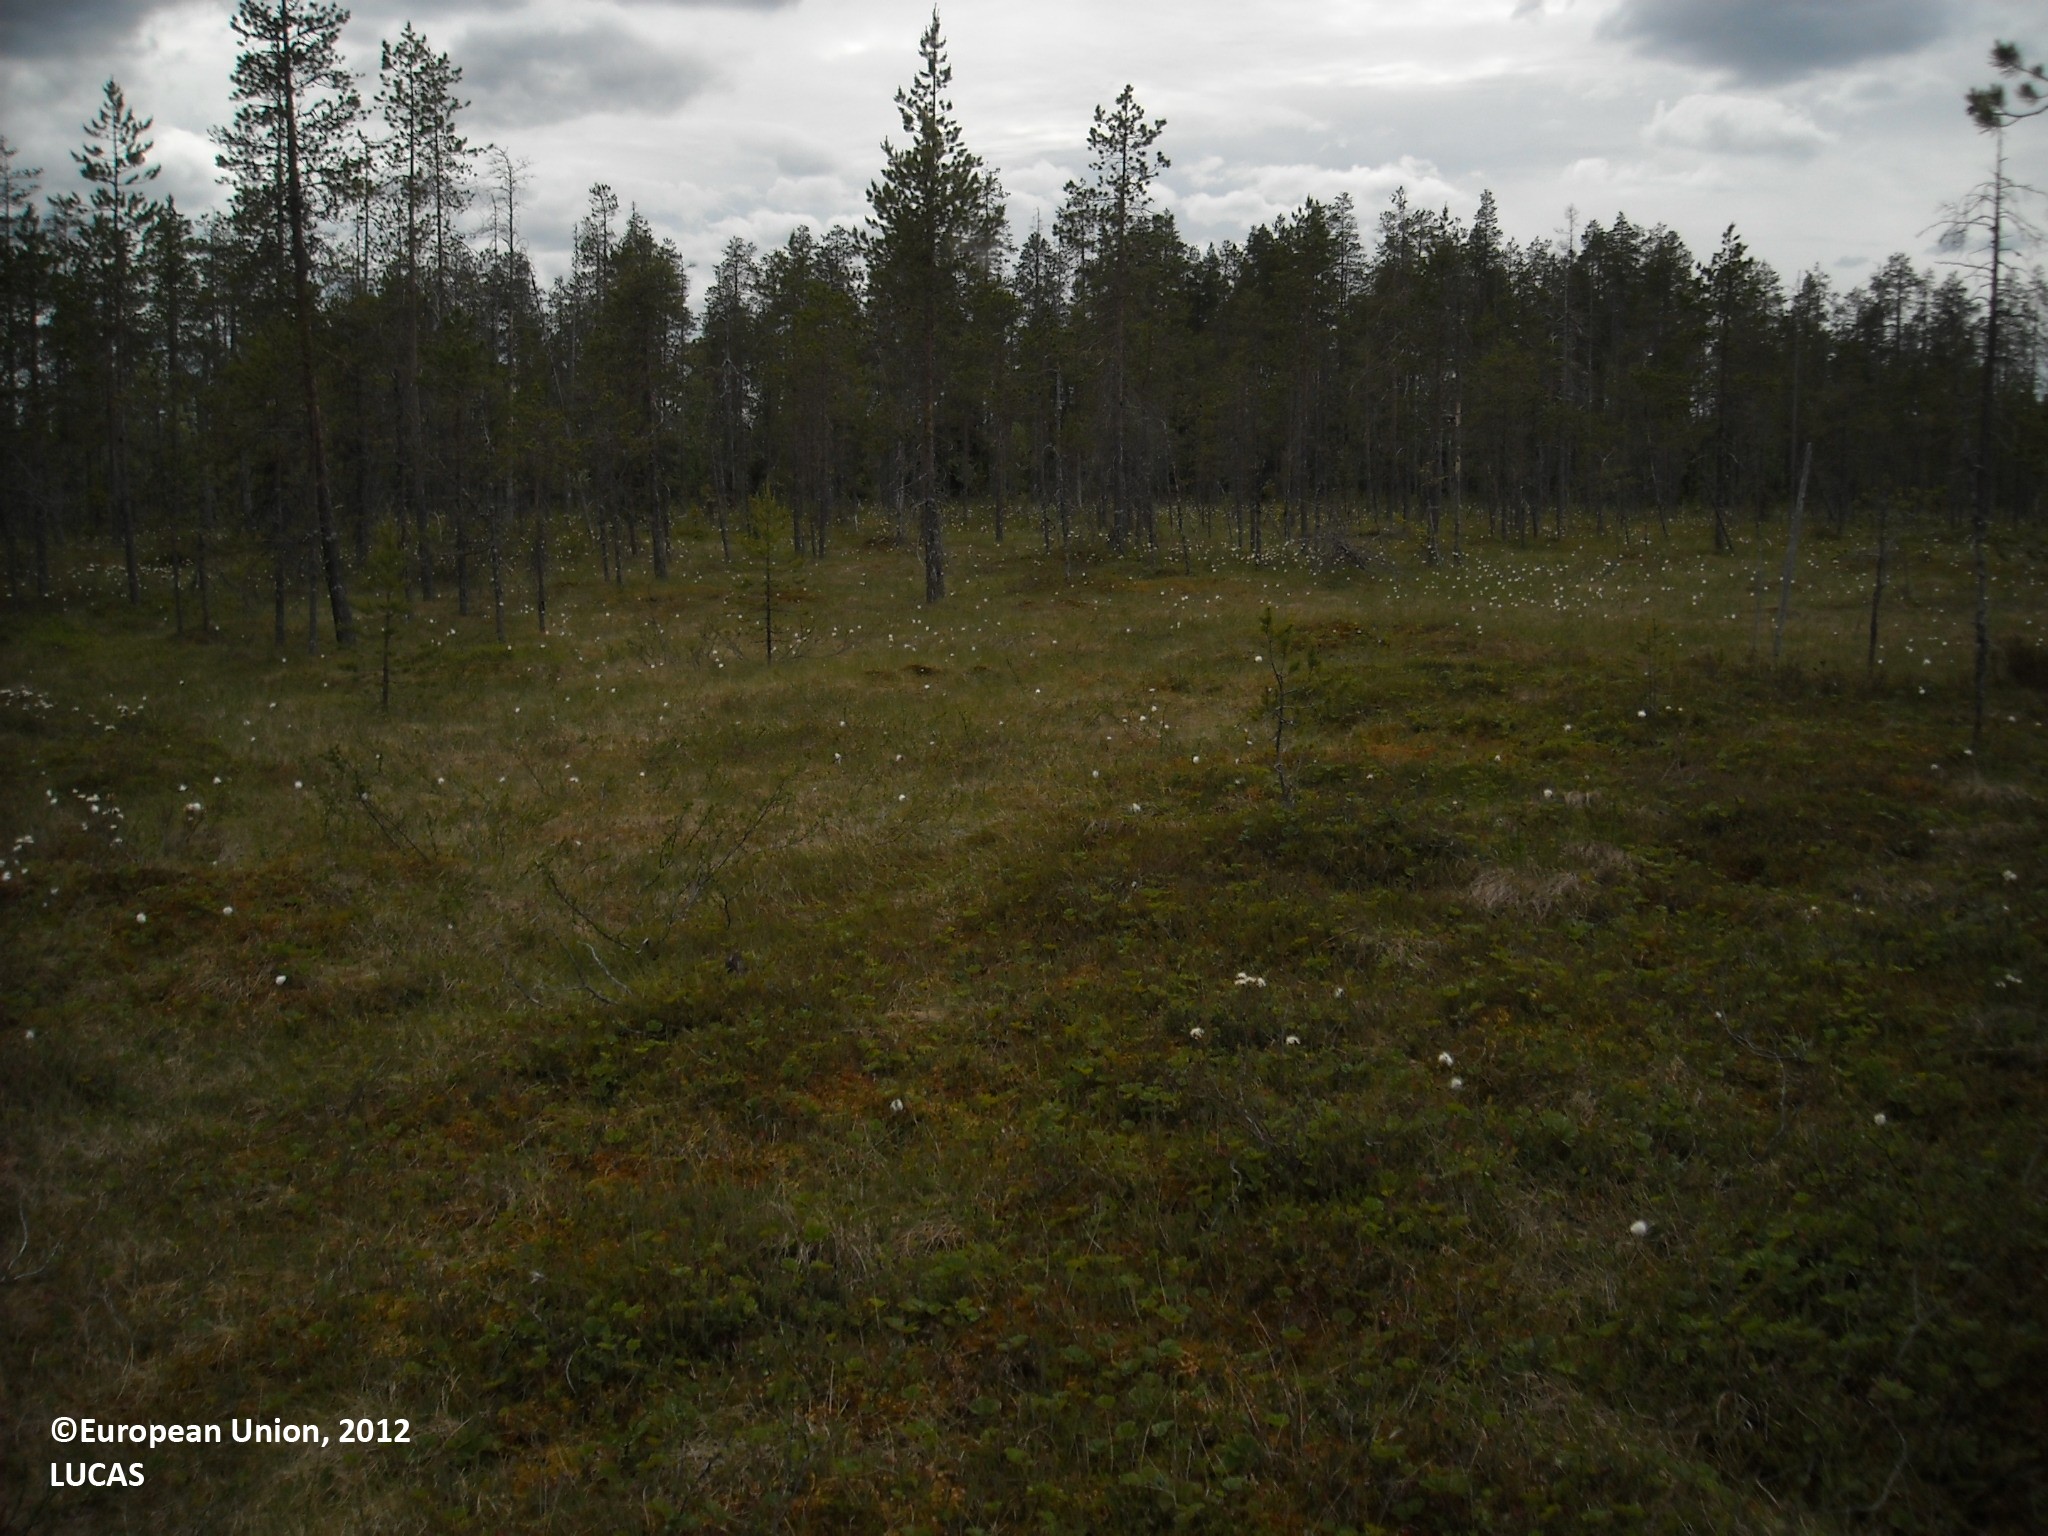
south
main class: Woodland
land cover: Pine dominated coniferous woodland
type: mire and swamp forests
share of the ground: 10 - 25 %
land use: Semi-natural and natural areas not in use
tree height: > 5 m
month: June
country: FI
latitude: 64.8843
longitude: 27.9961
